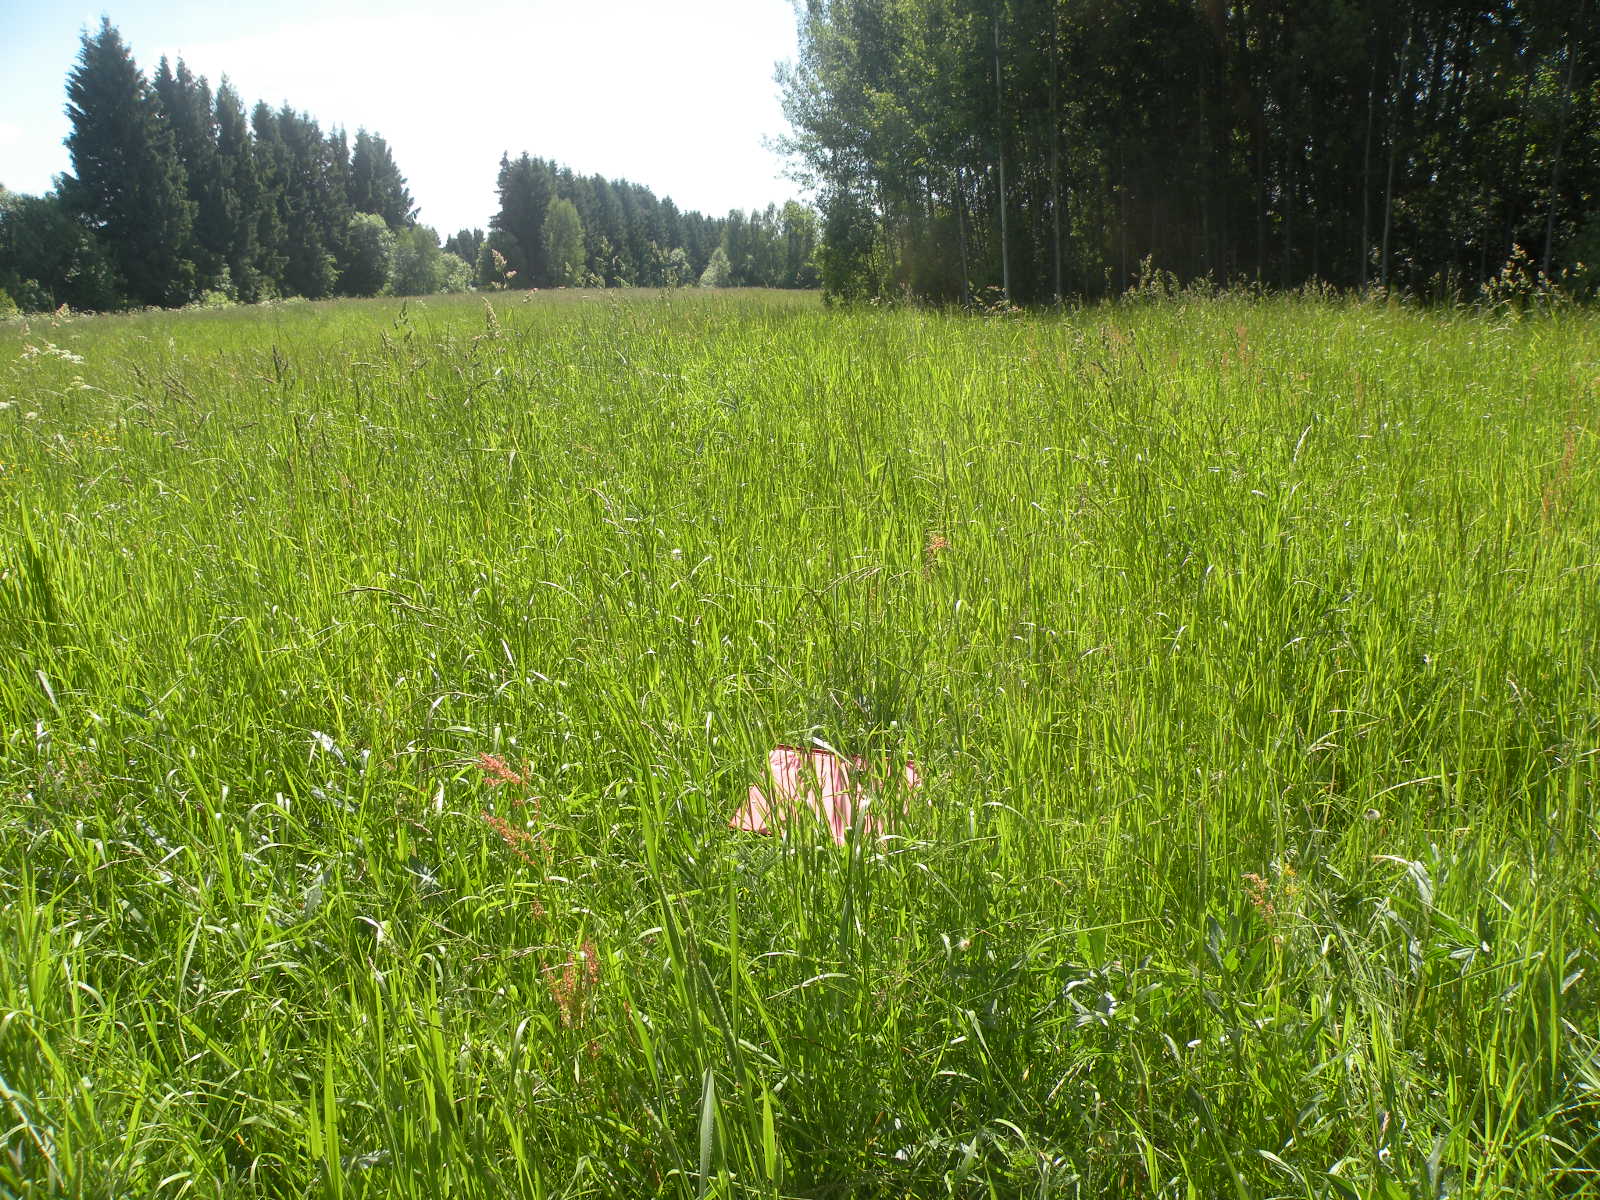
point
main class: Grassland
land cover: Grassland without tree/shrub cover
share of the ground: > 75 %
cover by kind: herbaceous plants 100 %
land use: Agriculture (excluding fallow land and kitchen gardens)
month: June
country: LV
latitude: 55.9297
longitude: 26.6900
